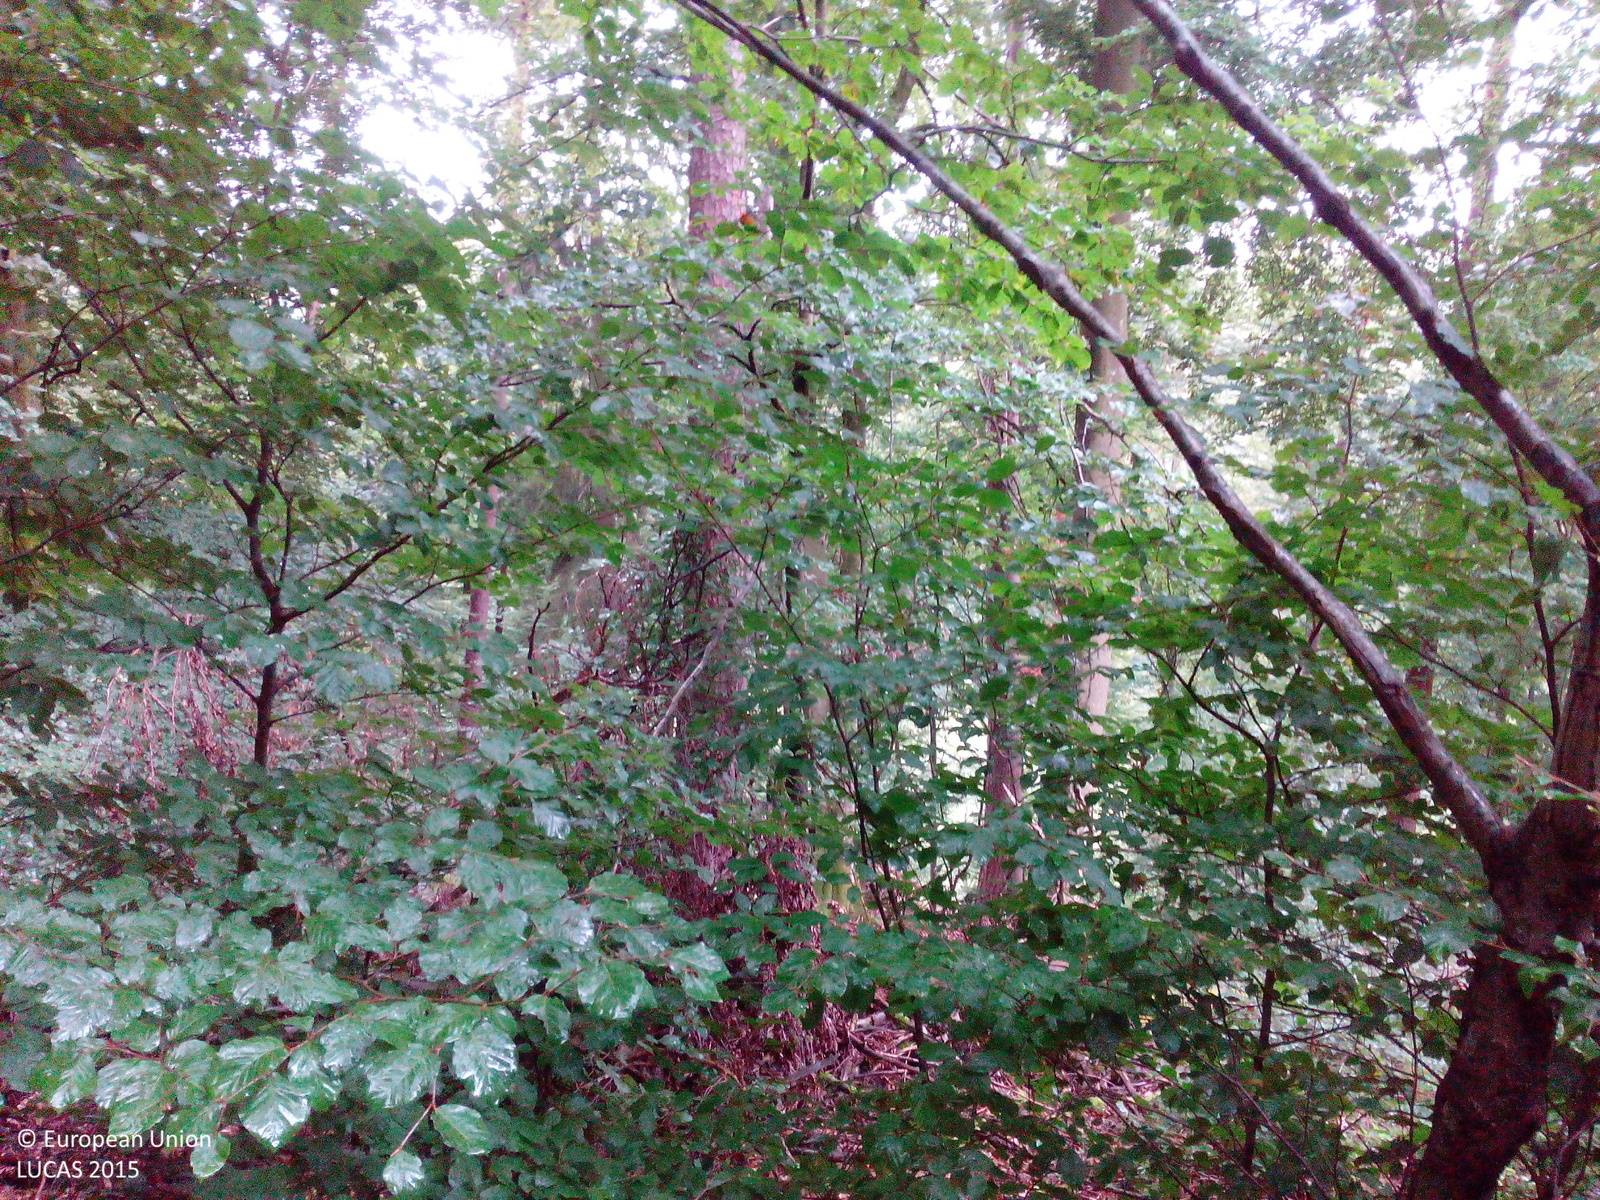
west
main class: Woodland
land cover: Pine dominated mixed woodland
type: hemiboreal forest and nemoral coniferous forest and mixed broadleaved-coniferous forest
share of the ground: > 75 %
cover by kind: broadleaved forest trees 65 %, coniferous forest trees 25 %, herbaceous plants 5 %, unconsolidated bare surface 5 %
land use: Forestry
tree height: > 5 m
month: September
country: DE
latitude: 49.9309
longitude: 9.4012
